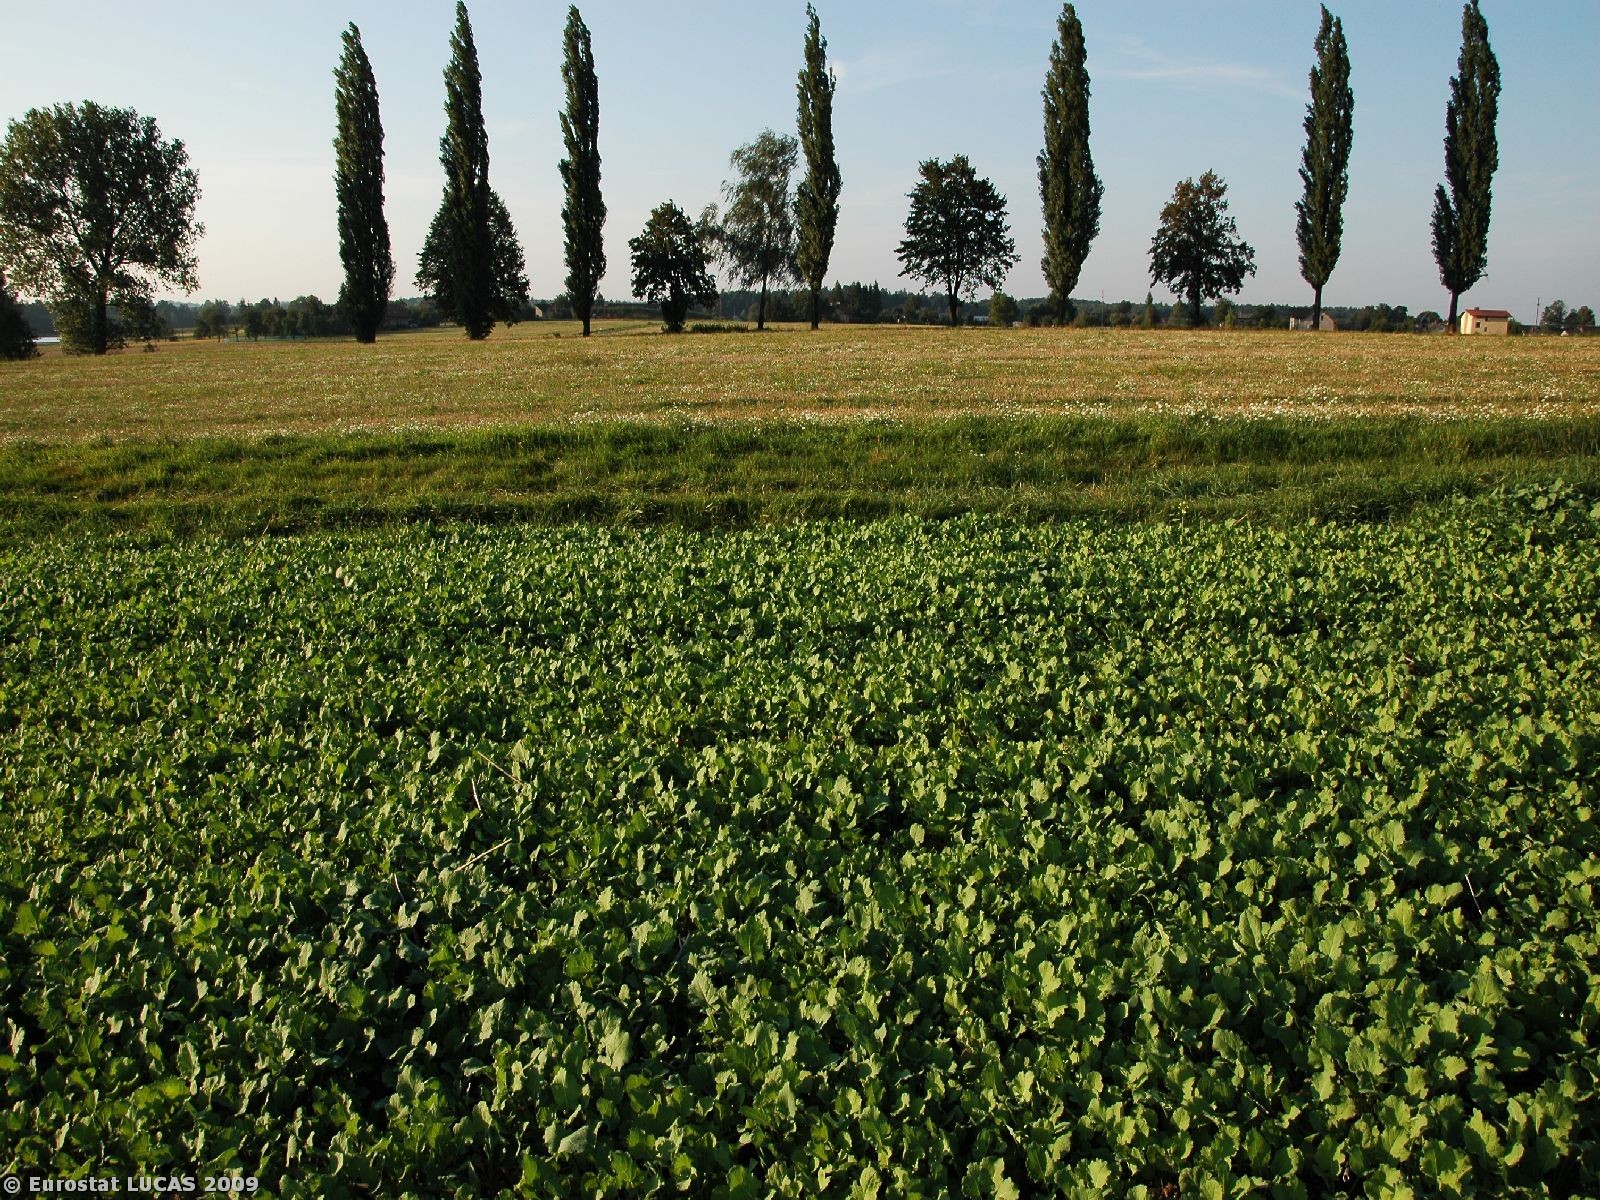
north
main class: Cropland
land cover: Rape and turnip rape
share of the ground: > 75 %
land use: Agriculture (excluding fallow land and kitchen gardens)
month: August
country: PL
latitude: 49.8145
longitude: 18.7063
